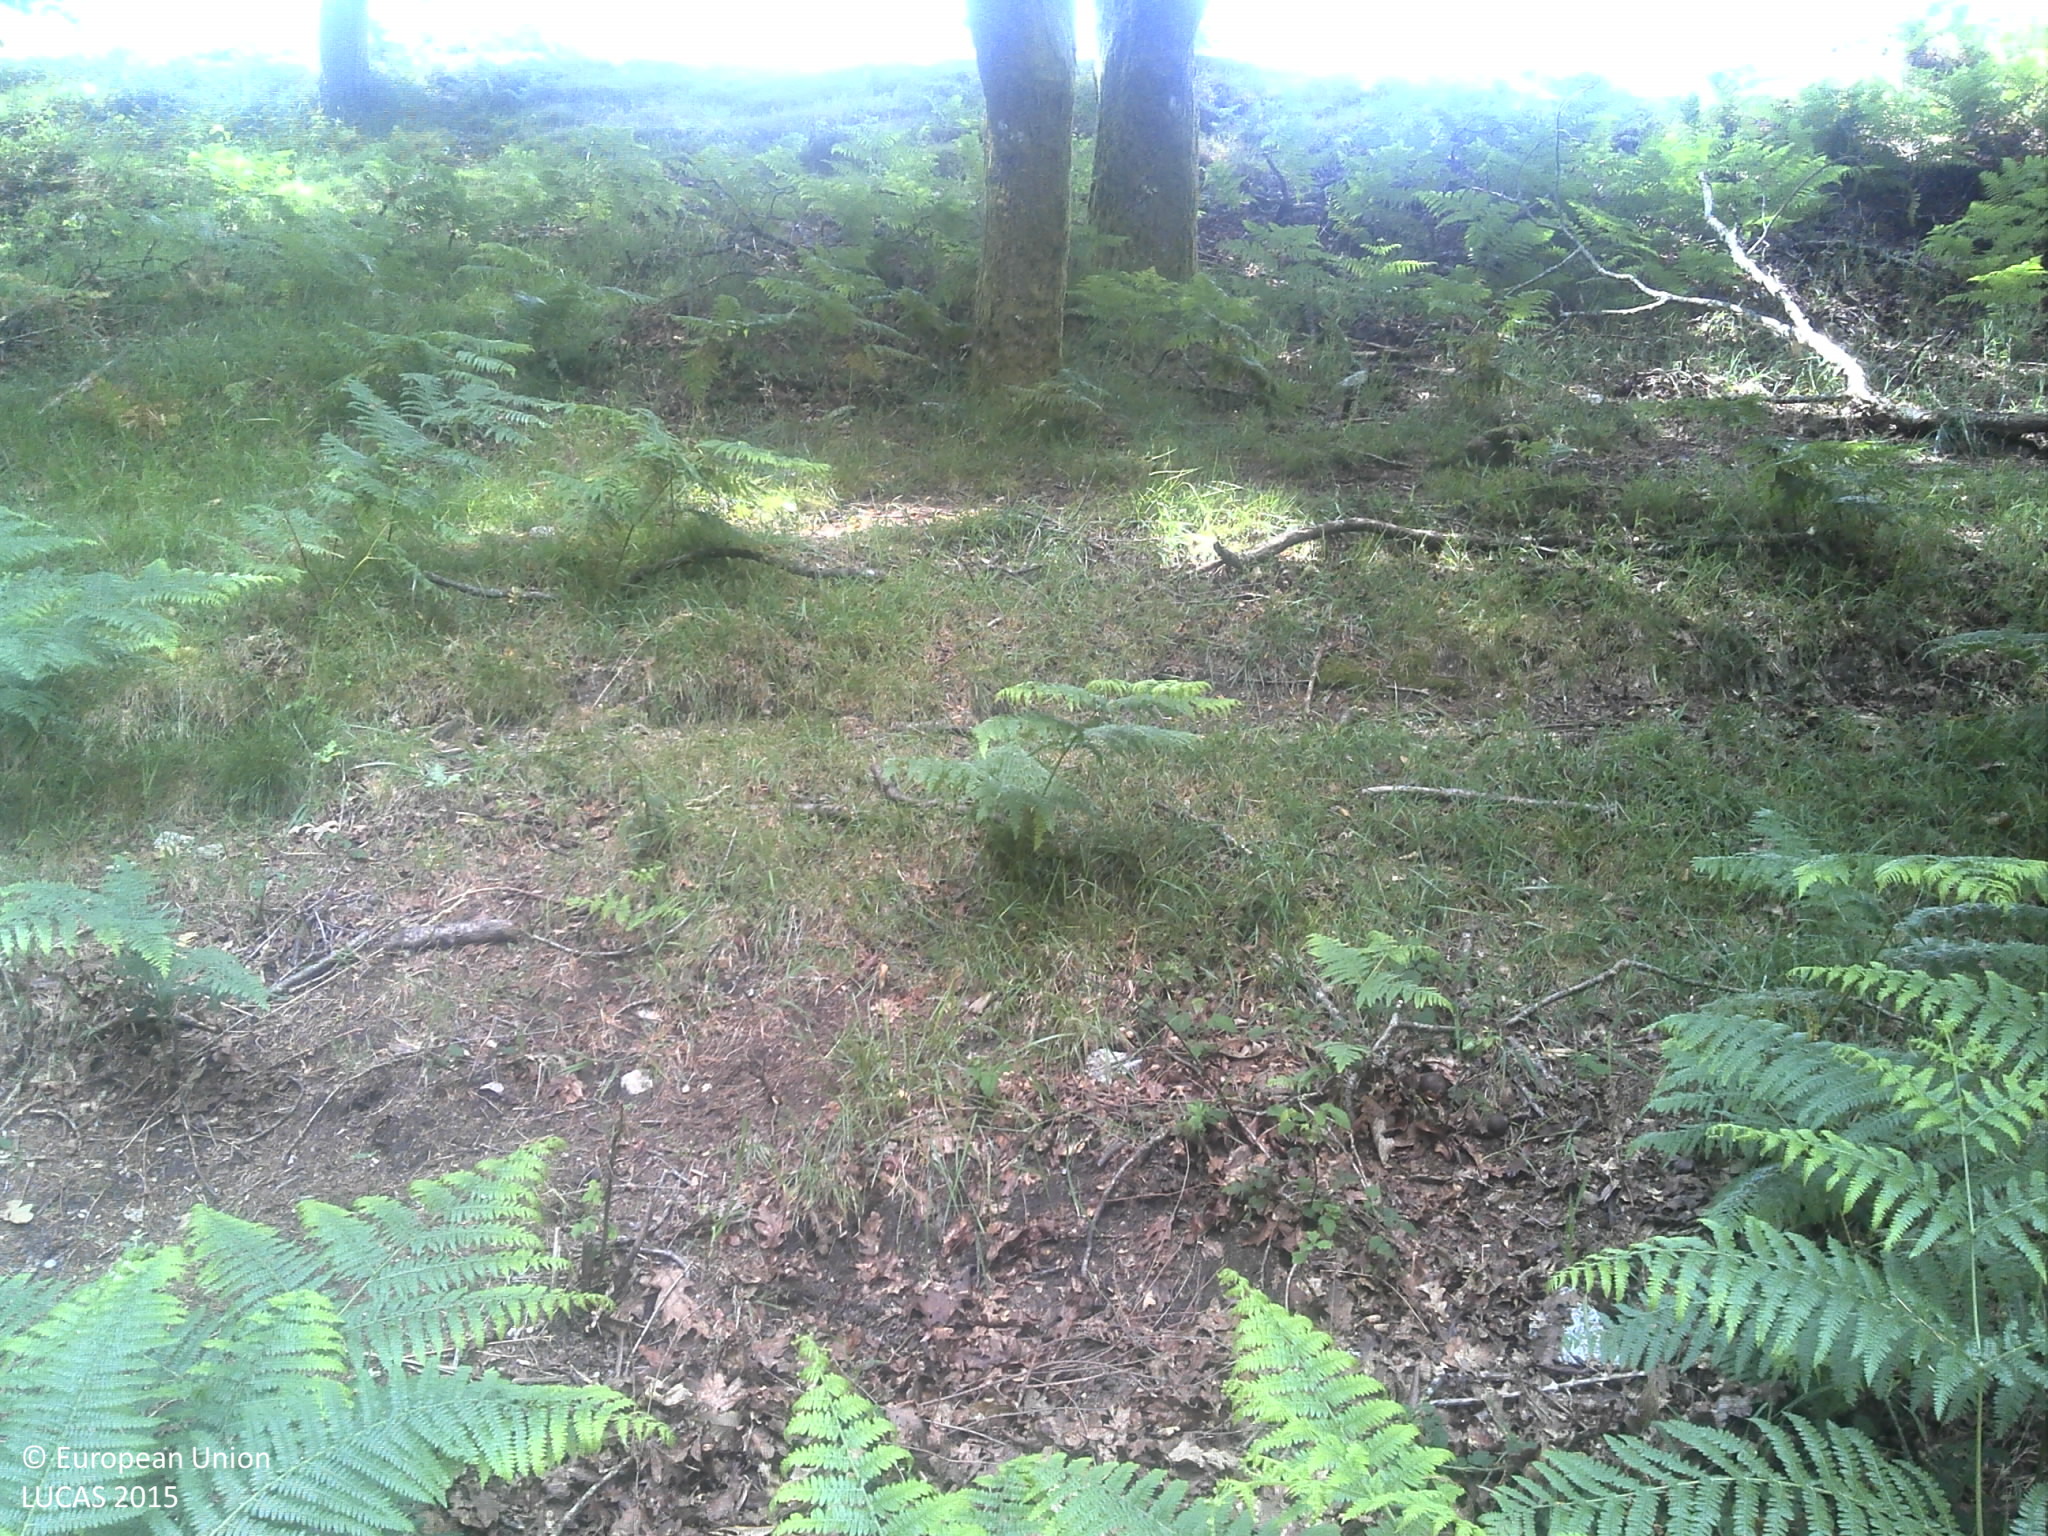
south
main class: Woodland
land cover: Other mixed woodland
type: mesophytic deciduous forest
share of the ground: 50 - 75 %
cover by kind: coniferous forest trees 50 %, shrubs 25 %, broadleaved forest trees 20 %, herbaceous plants 5 %
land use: Agriculture (excluding fallow land and kitchen gardens)
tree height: > 5 m
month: June
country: PT
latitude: 41.6934
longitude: -8.2831
